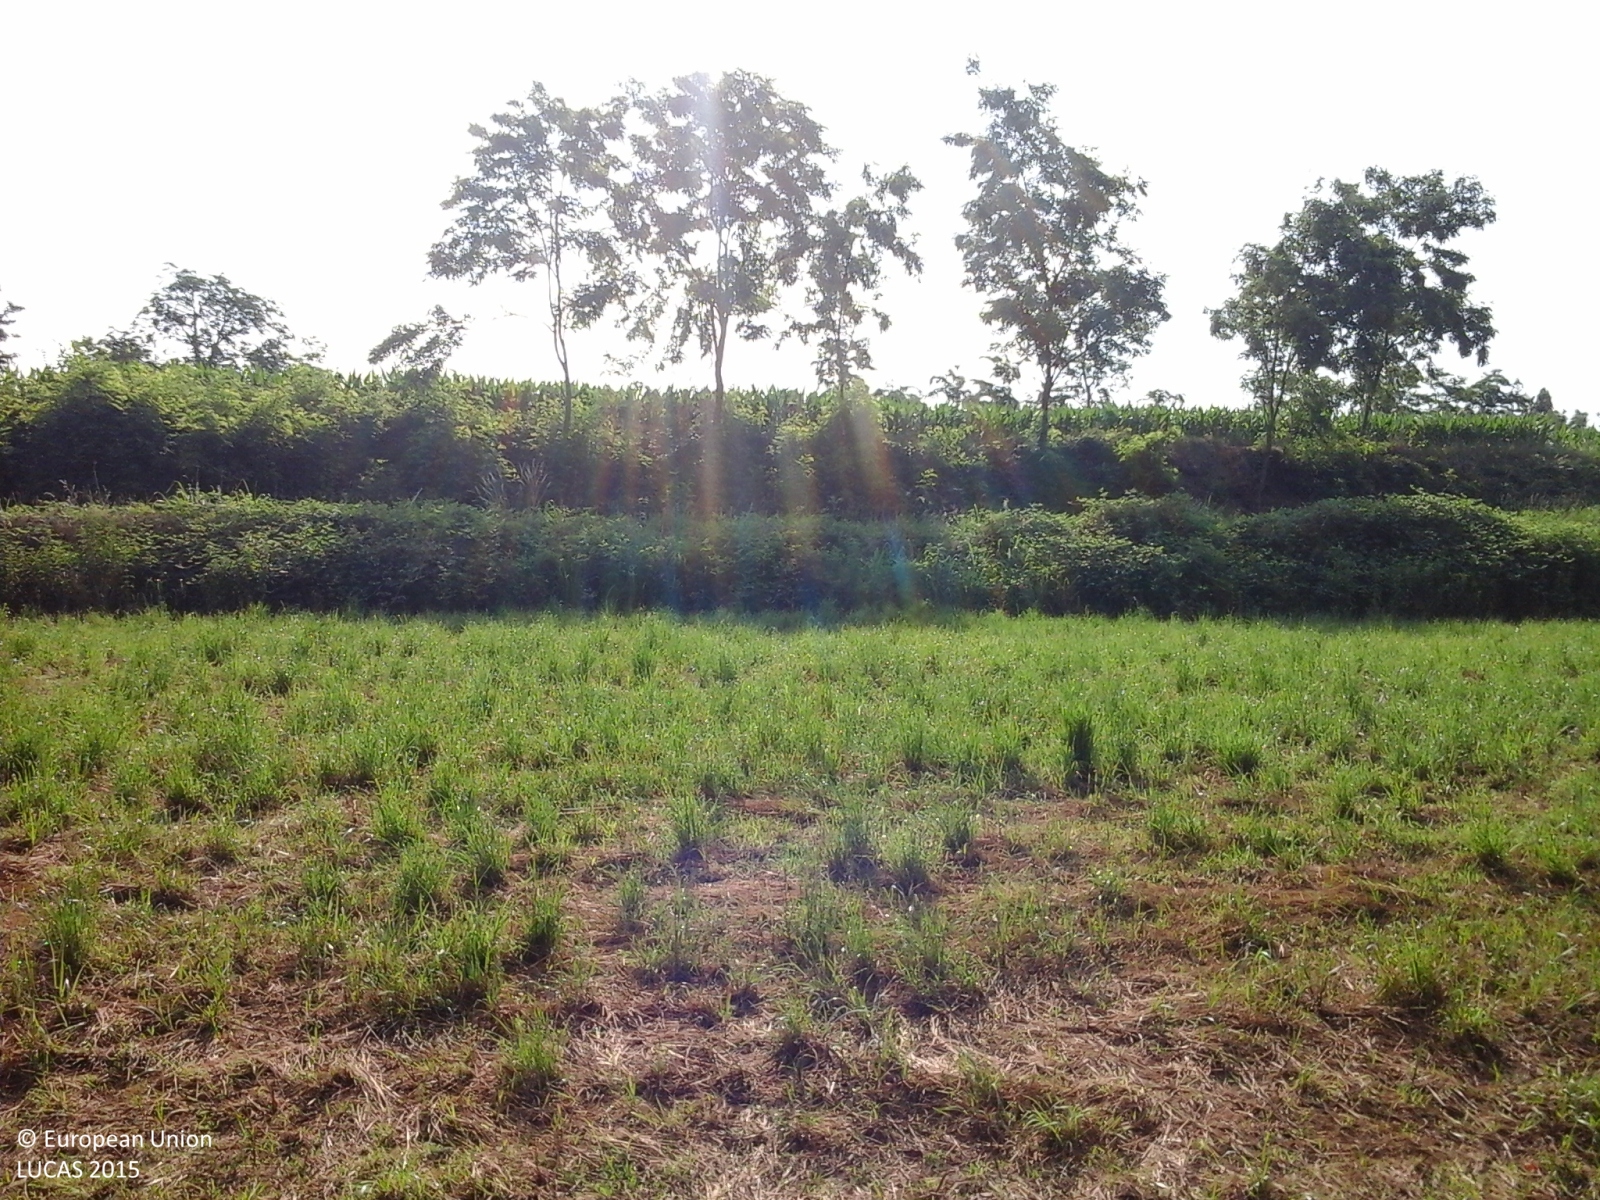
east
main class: Cropland
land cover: Temporary grasslands
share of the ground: > 75 %
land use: Agriculture (excluding fallow land and kitchen gardens)
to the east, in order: Temporary grasslands; Grass margins; Tracks; Grassland without tree/shrub cover; Abandoned hedges; Maize; Ditches and canals; Abandoned hedges; Maize; Electric lines; Maize
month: June
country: IT
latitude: 45.3234
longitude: 9.6052
